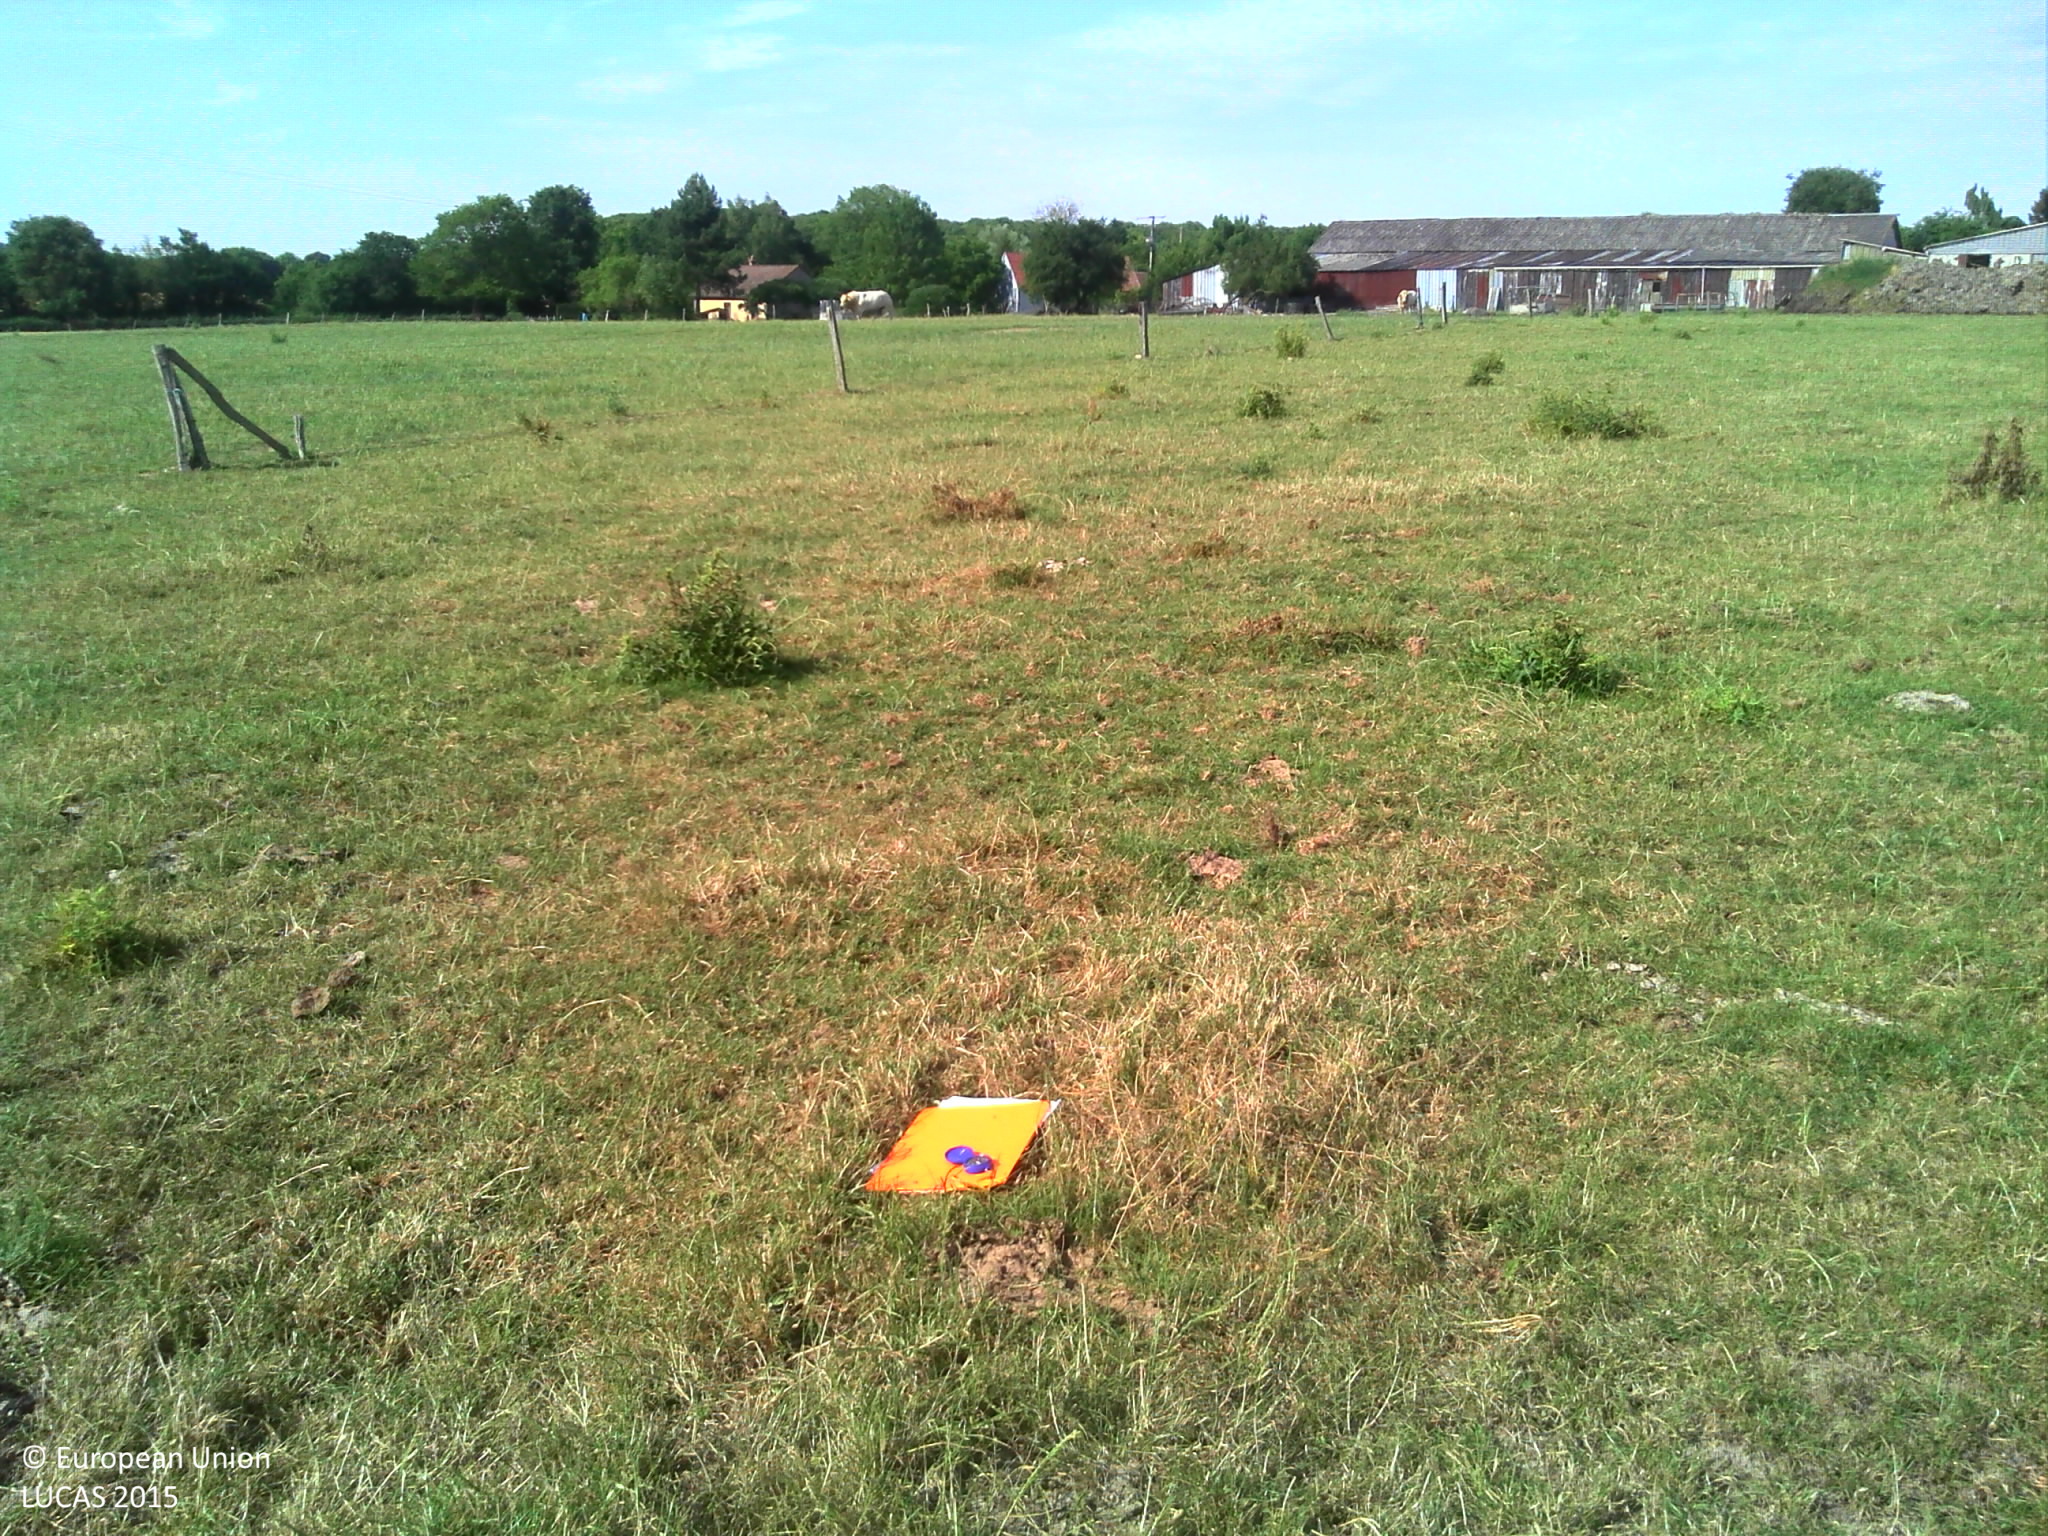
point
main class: Grassland
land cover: Grassland without tree/shrub cover
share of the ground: > 75 %
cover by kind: herbaceous plants 100 %
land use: Agriculture (excluding fallow land and kitchen gardens)
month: June
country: FR
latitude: 47.5619
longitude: 2.6427
